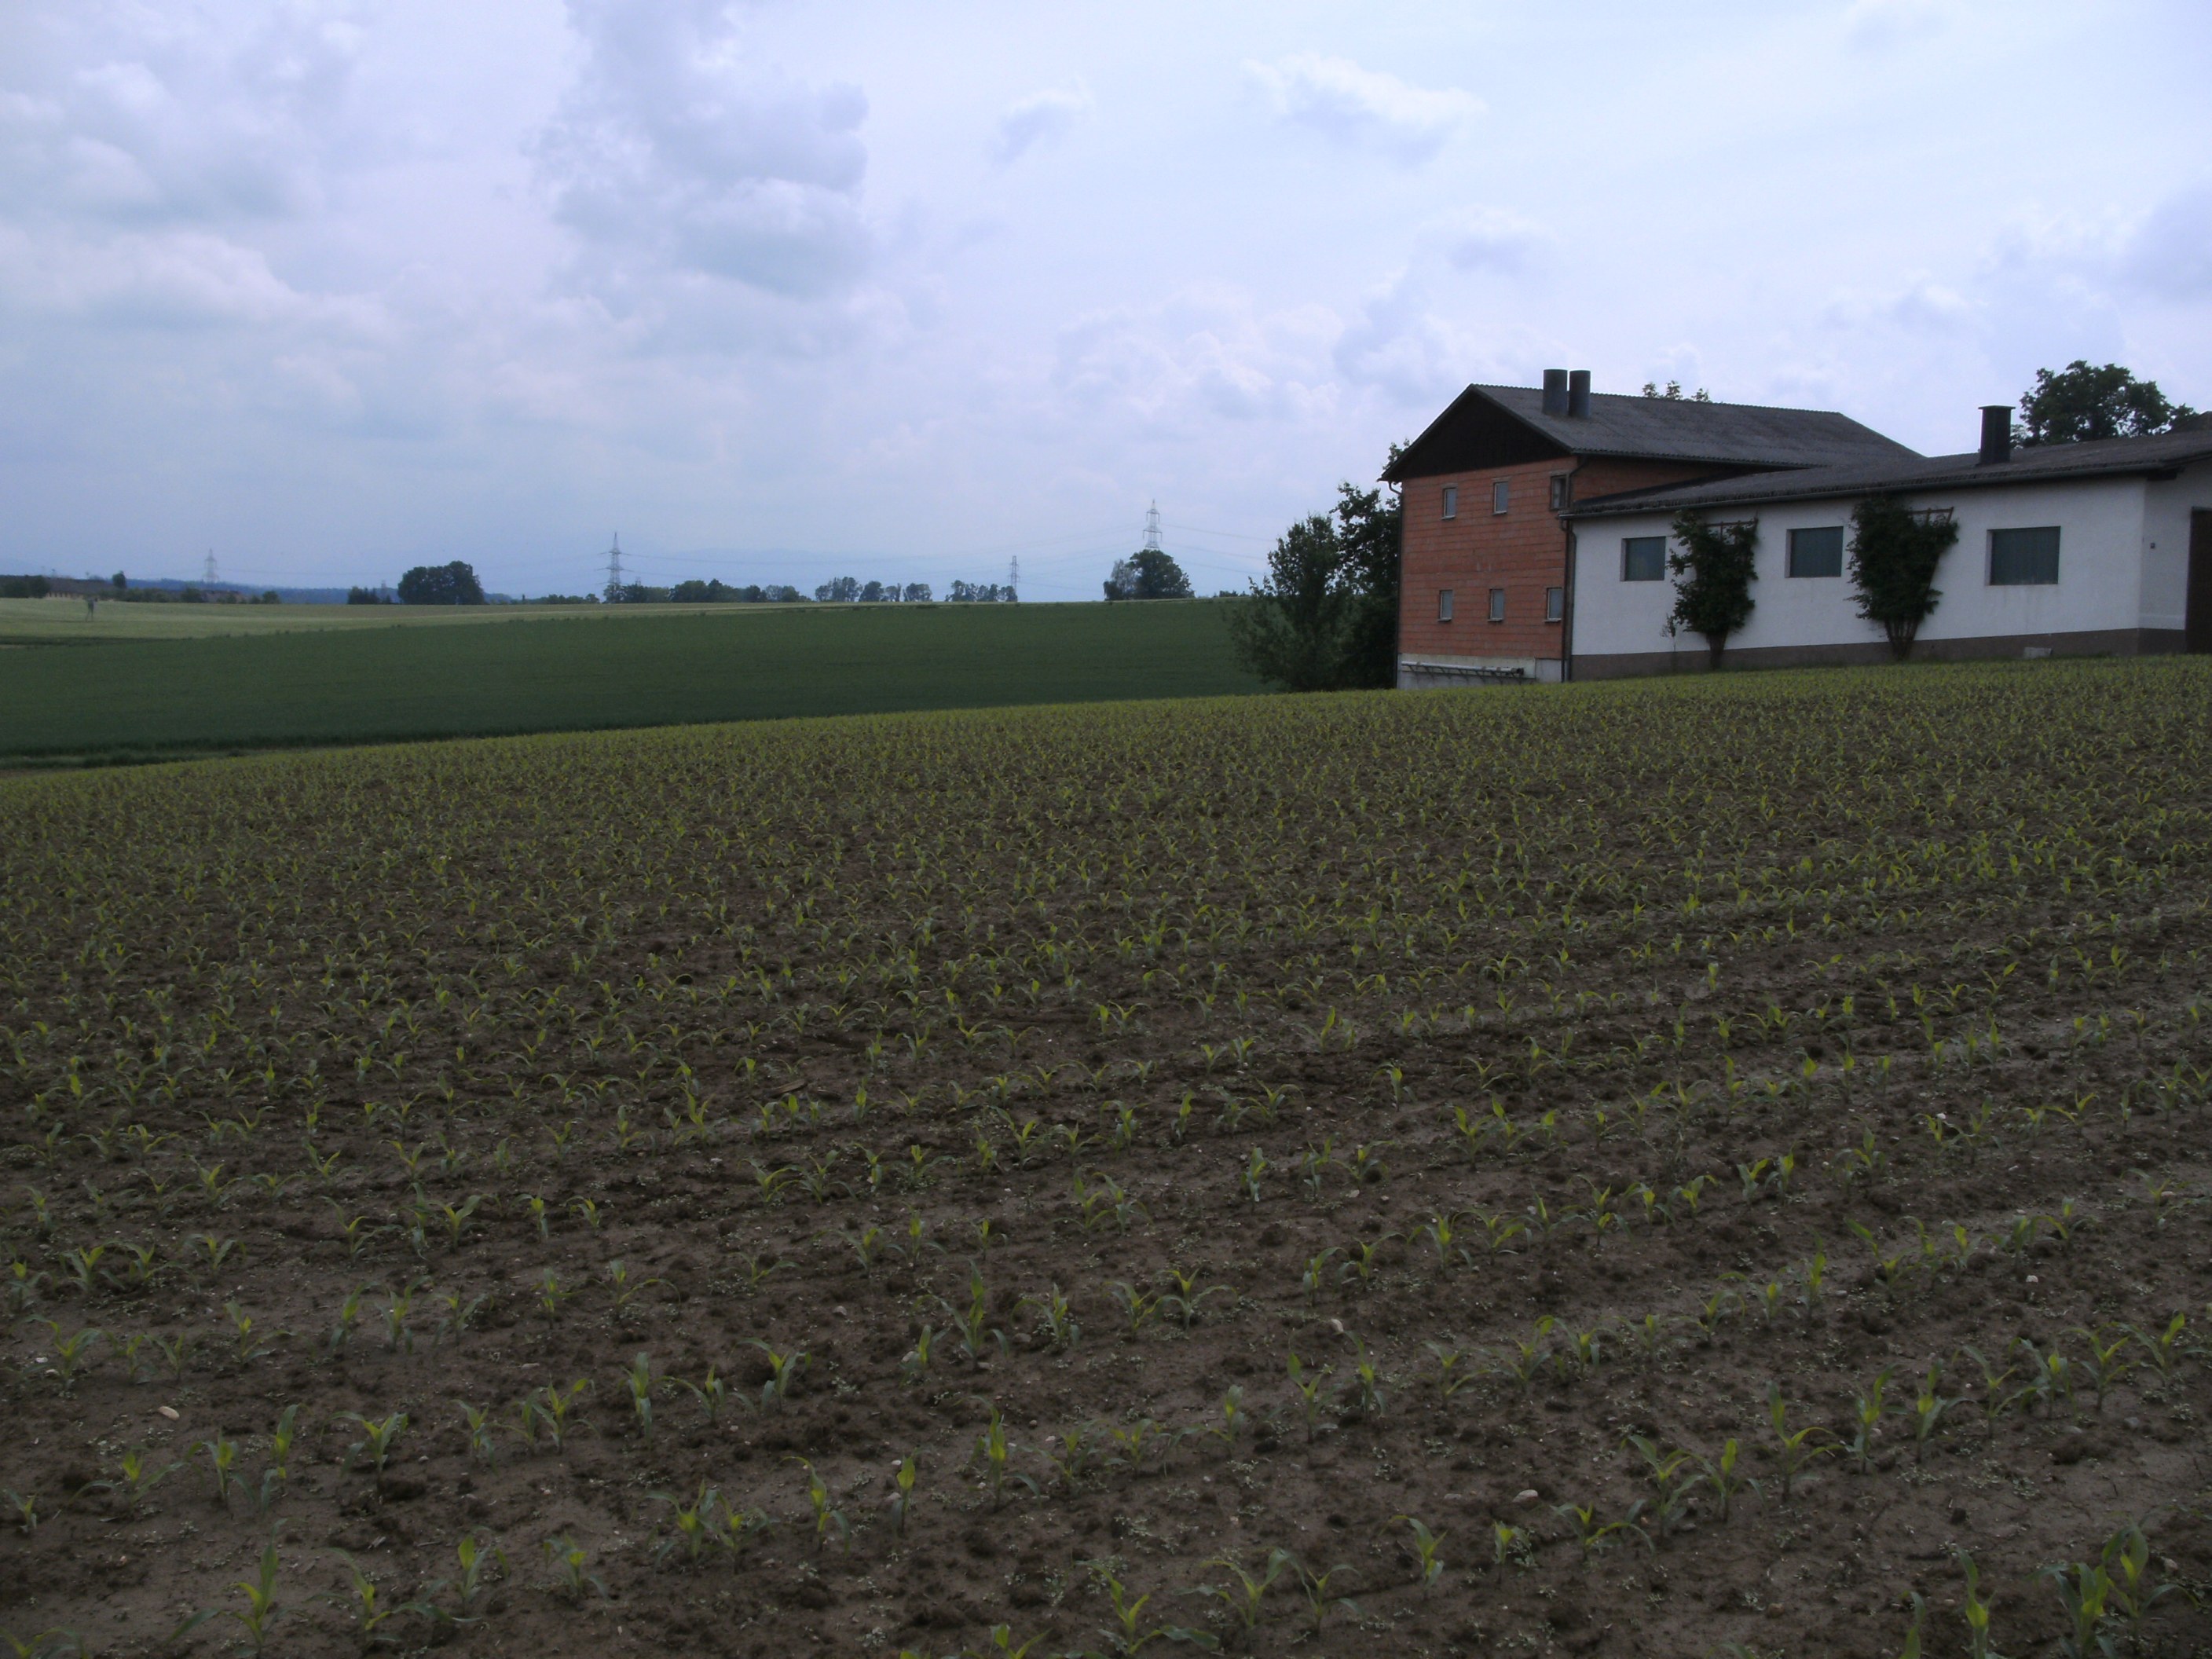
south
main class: Cropland
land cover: Maize
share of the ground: < 10 %
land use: Agriculture (excluding fallow land and kitchen gardens)
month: May
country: AT
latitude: 48.0964
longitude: 14.0144
